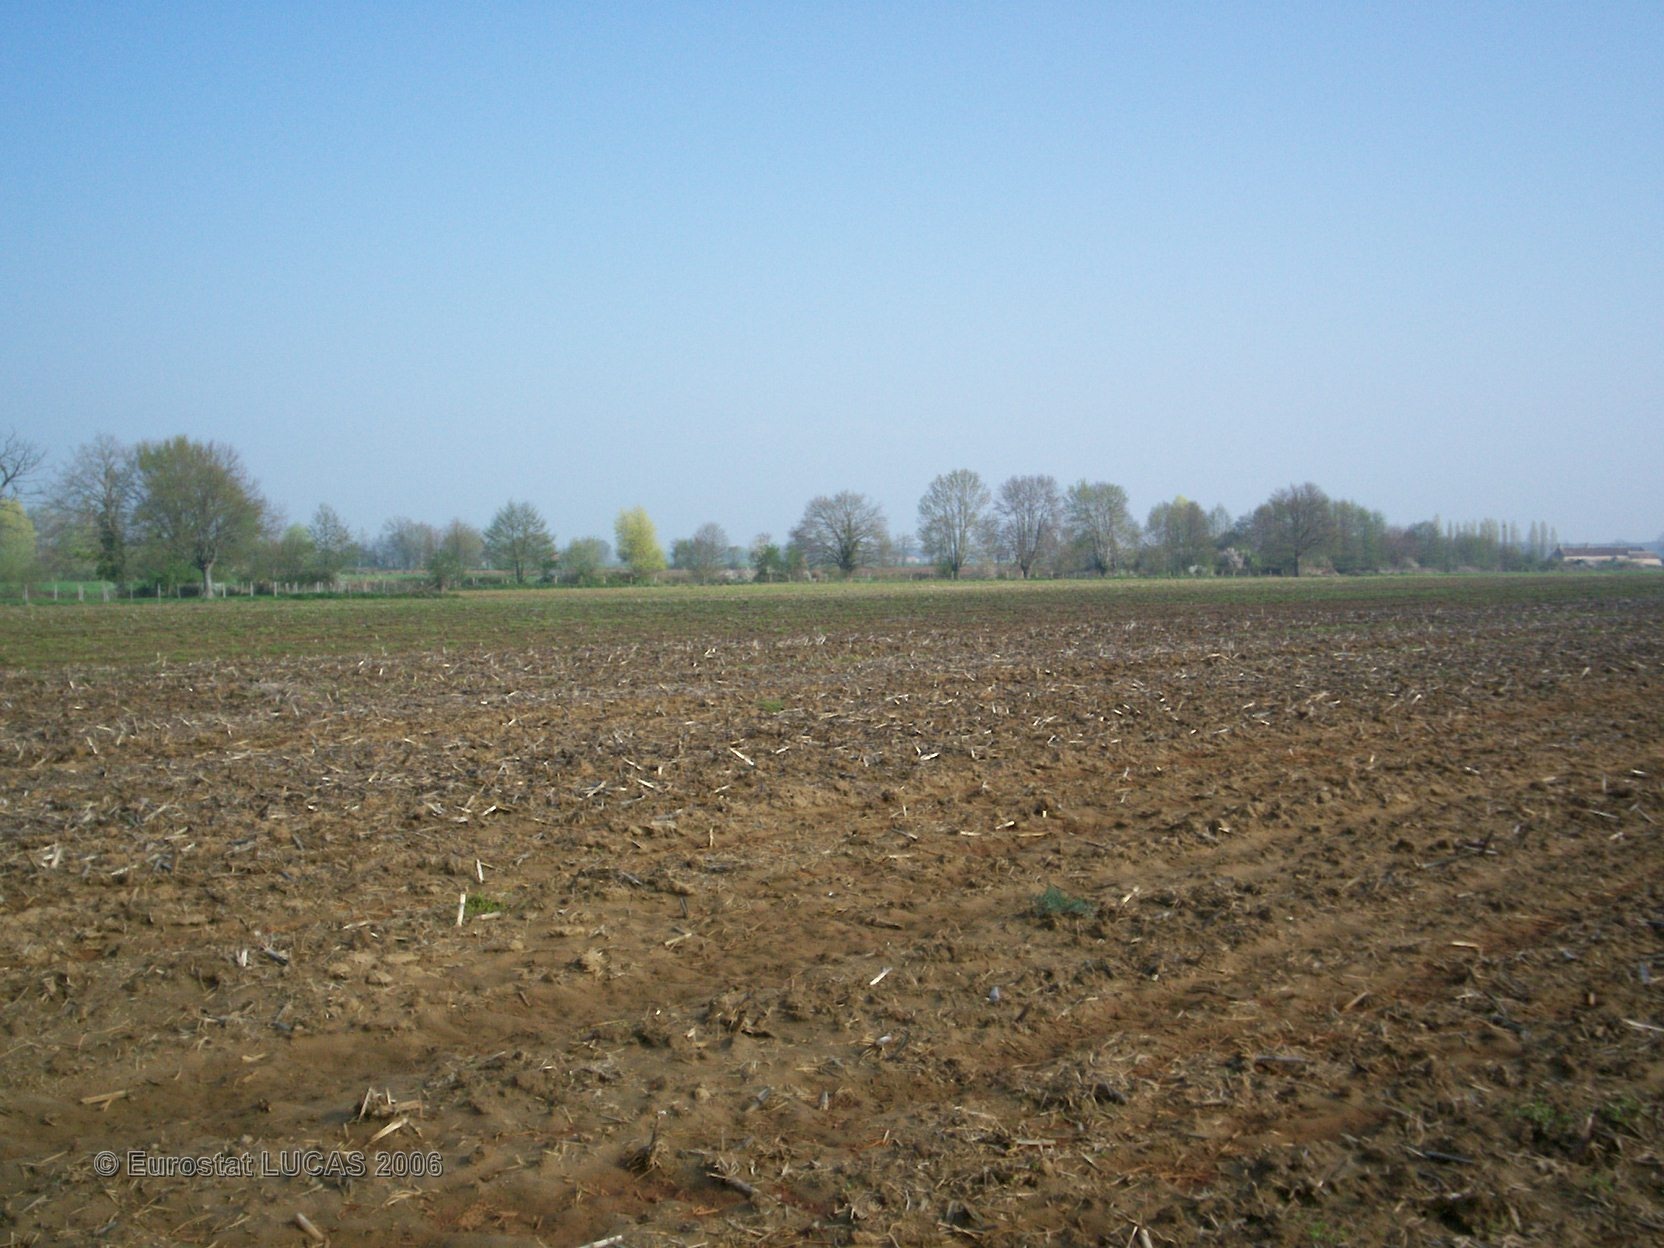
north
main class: Cropland
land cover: Maize
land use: Agriculture (excluding fallow land and kitchen gardens)
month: May
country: FR
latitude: 48.0736
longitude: 0.3789
